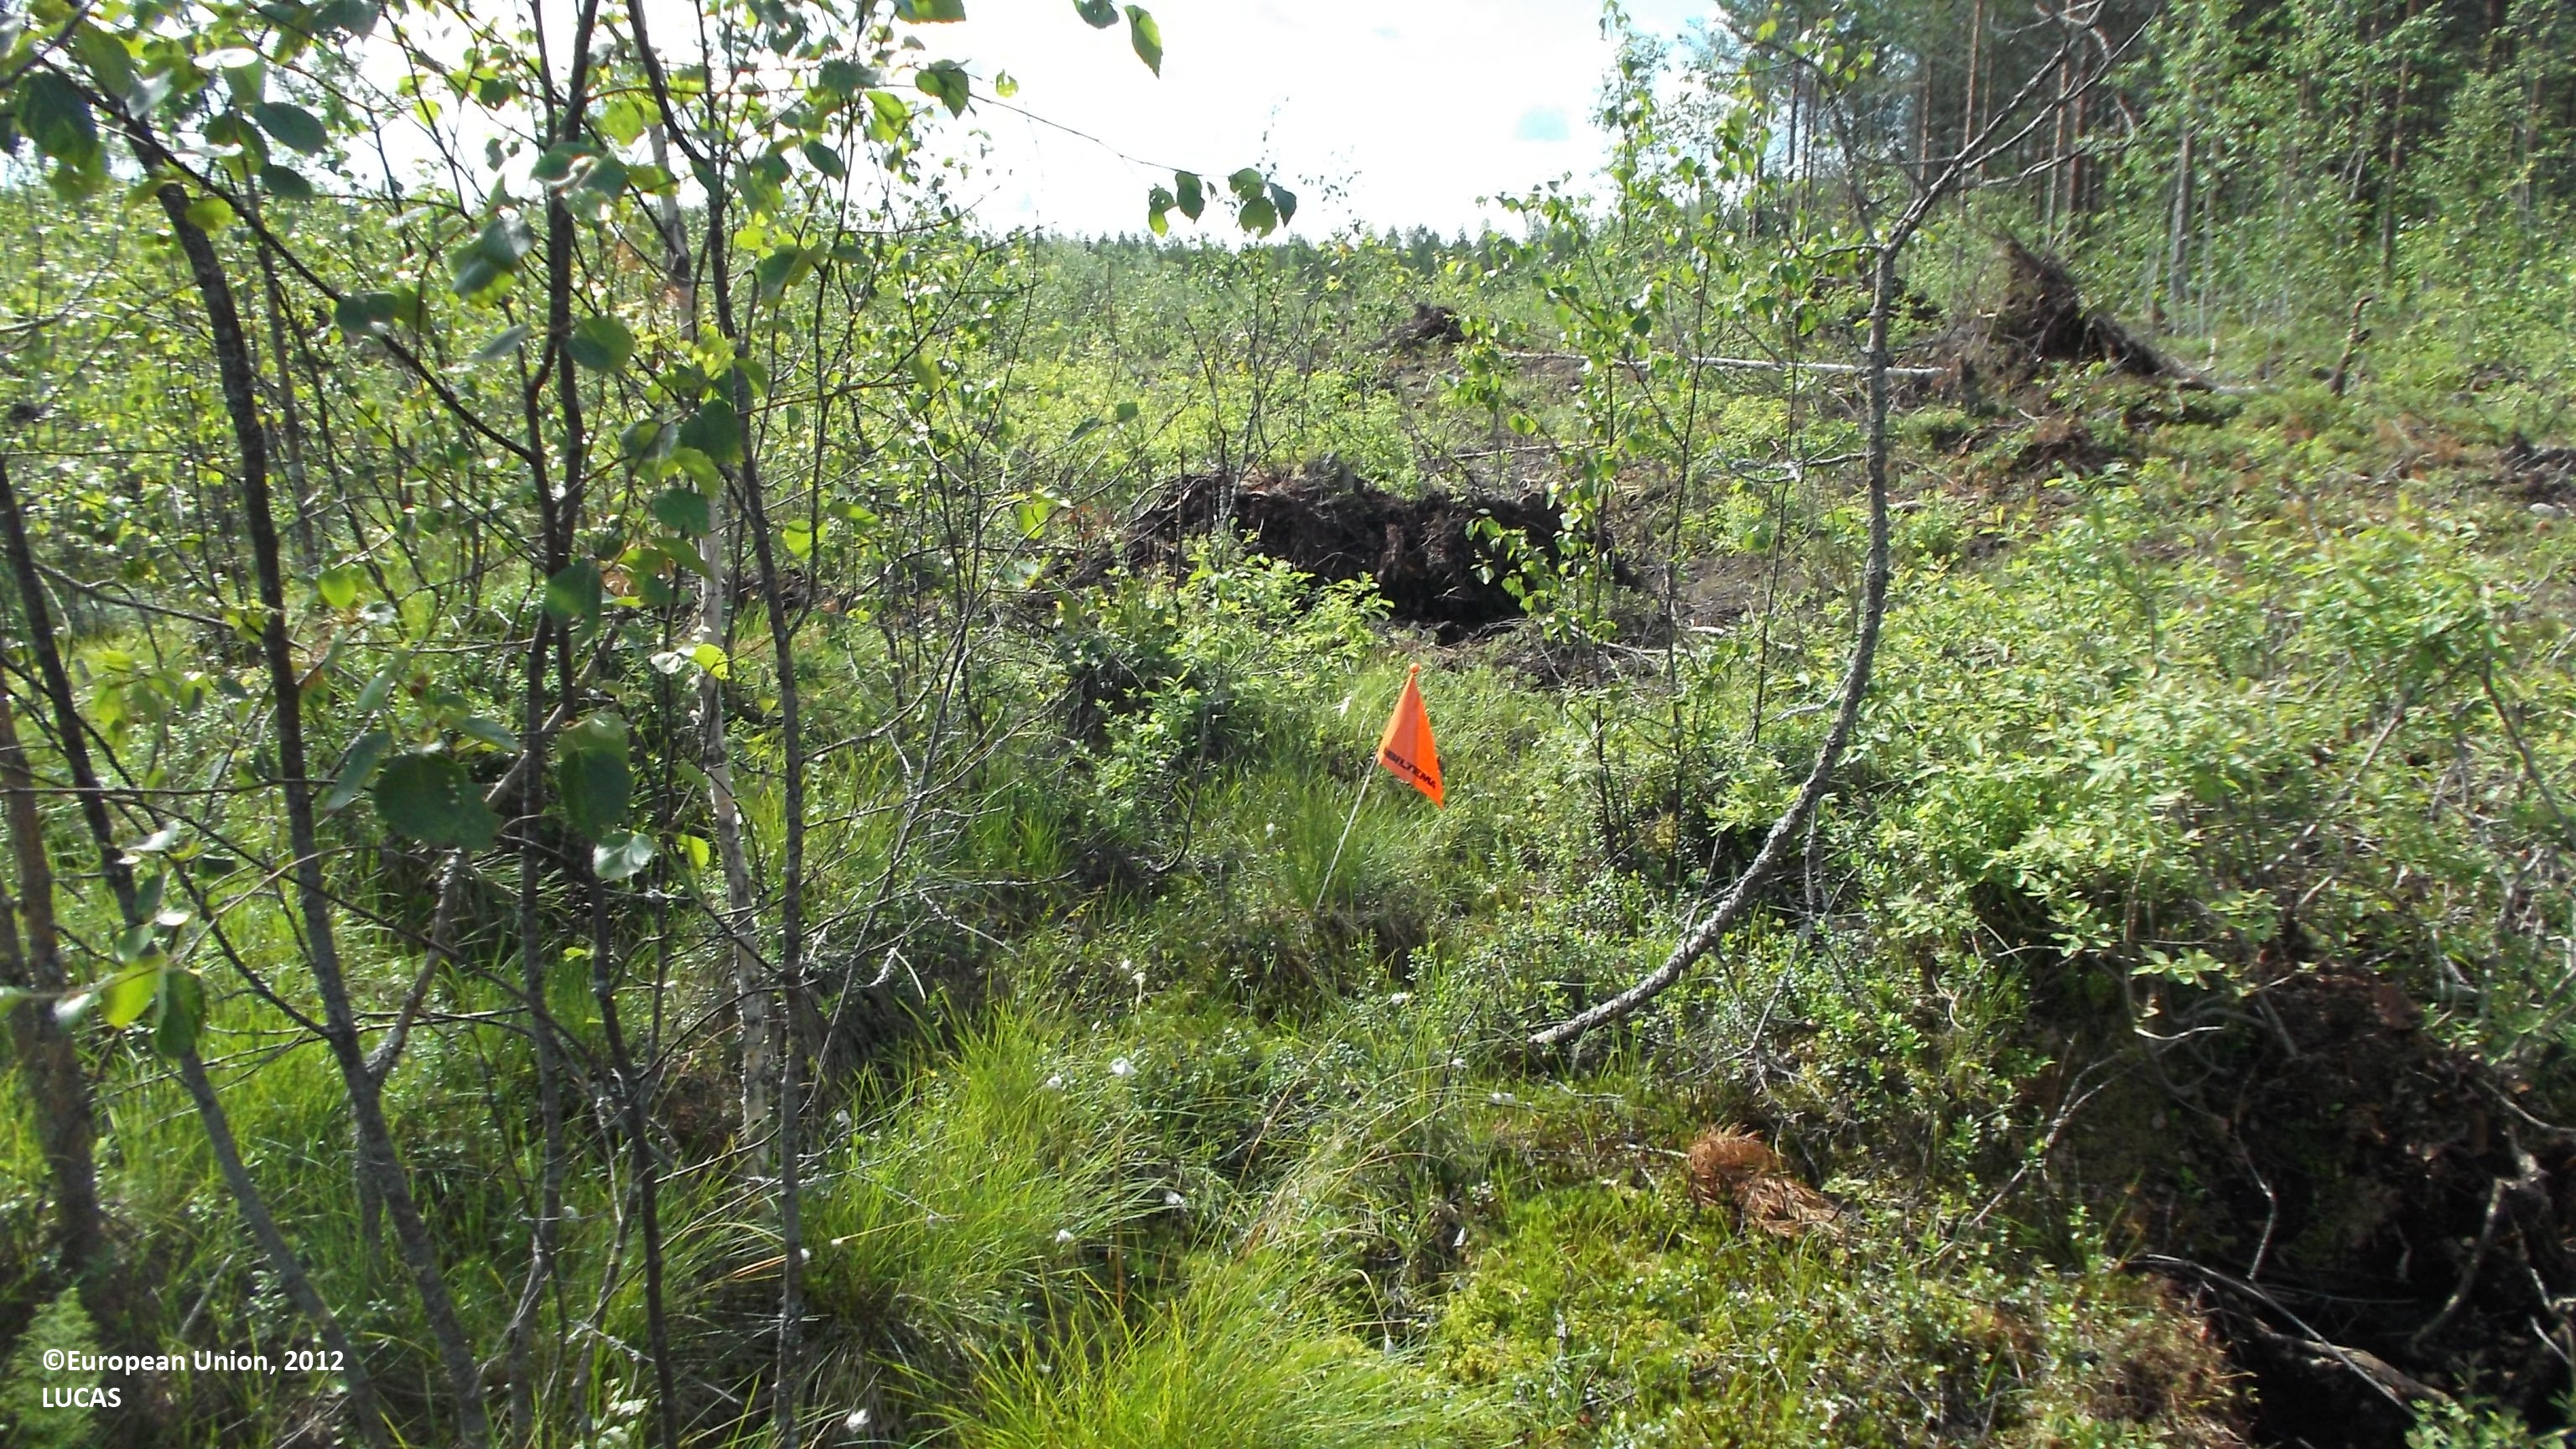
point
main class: Woodland
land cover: Broadleaved woodland
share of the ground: 10 - 25 %
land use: Forestry
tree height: < 5 m
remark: Clear cut
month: July
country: FI
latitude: 63.5197
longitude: 23.9598
